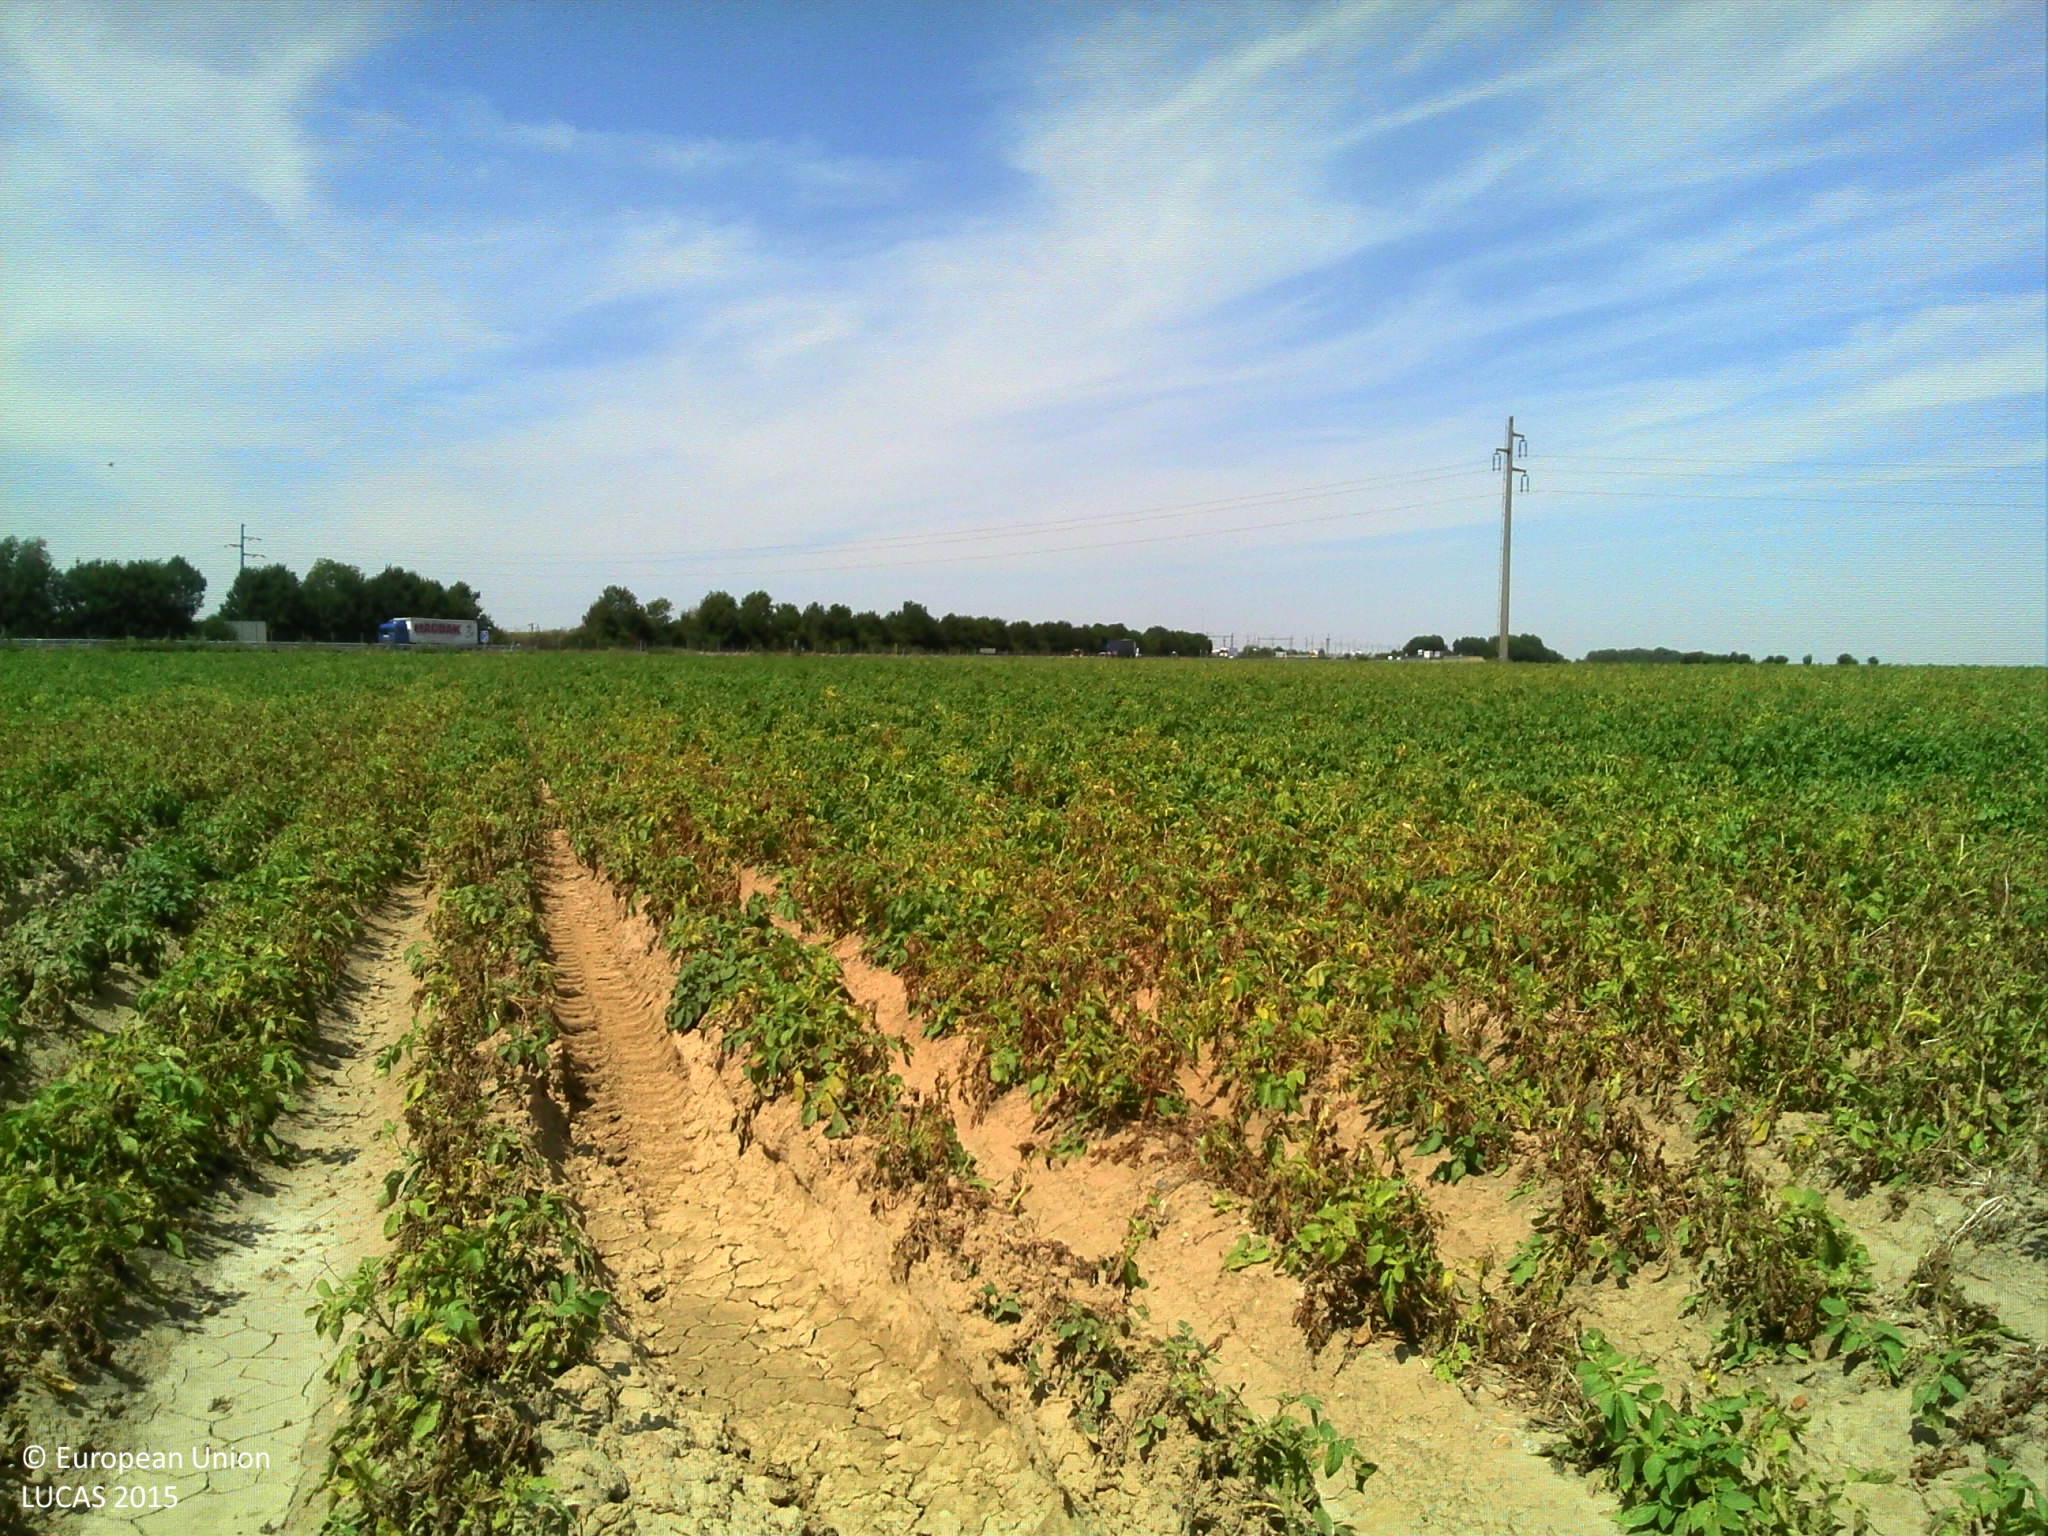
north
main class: Cropland
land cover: Potatoes
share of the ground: 25 - 50 %
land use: Agriculture (excluding fallow land and kitchen gardens)
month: August
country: FR
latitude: 49.7390
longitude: 2.7877
